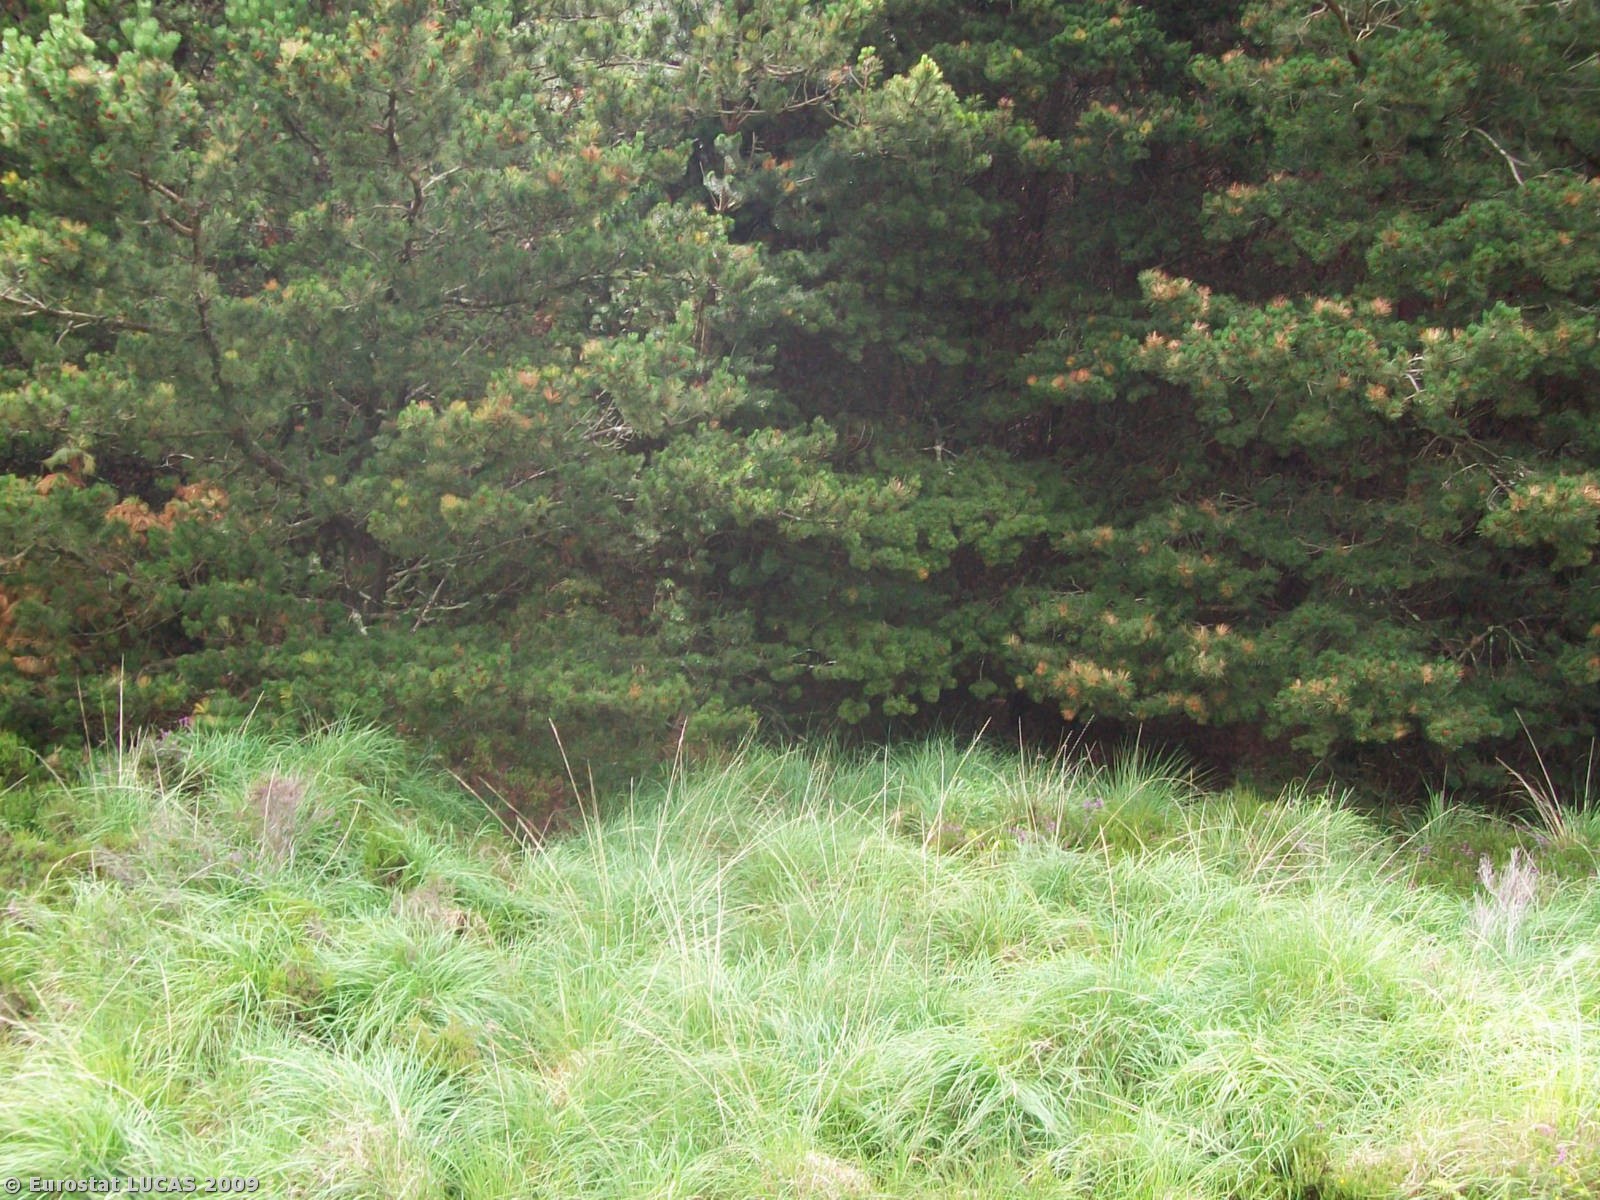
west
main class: Woodland
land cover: Coniferous woodland
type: plantations and self-sown exotic forest
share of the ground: > 75 %
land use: Forestry
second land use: Nature reserves
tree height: > 5 m
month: July
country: IE
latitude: 54.0814
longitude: -9.7942
